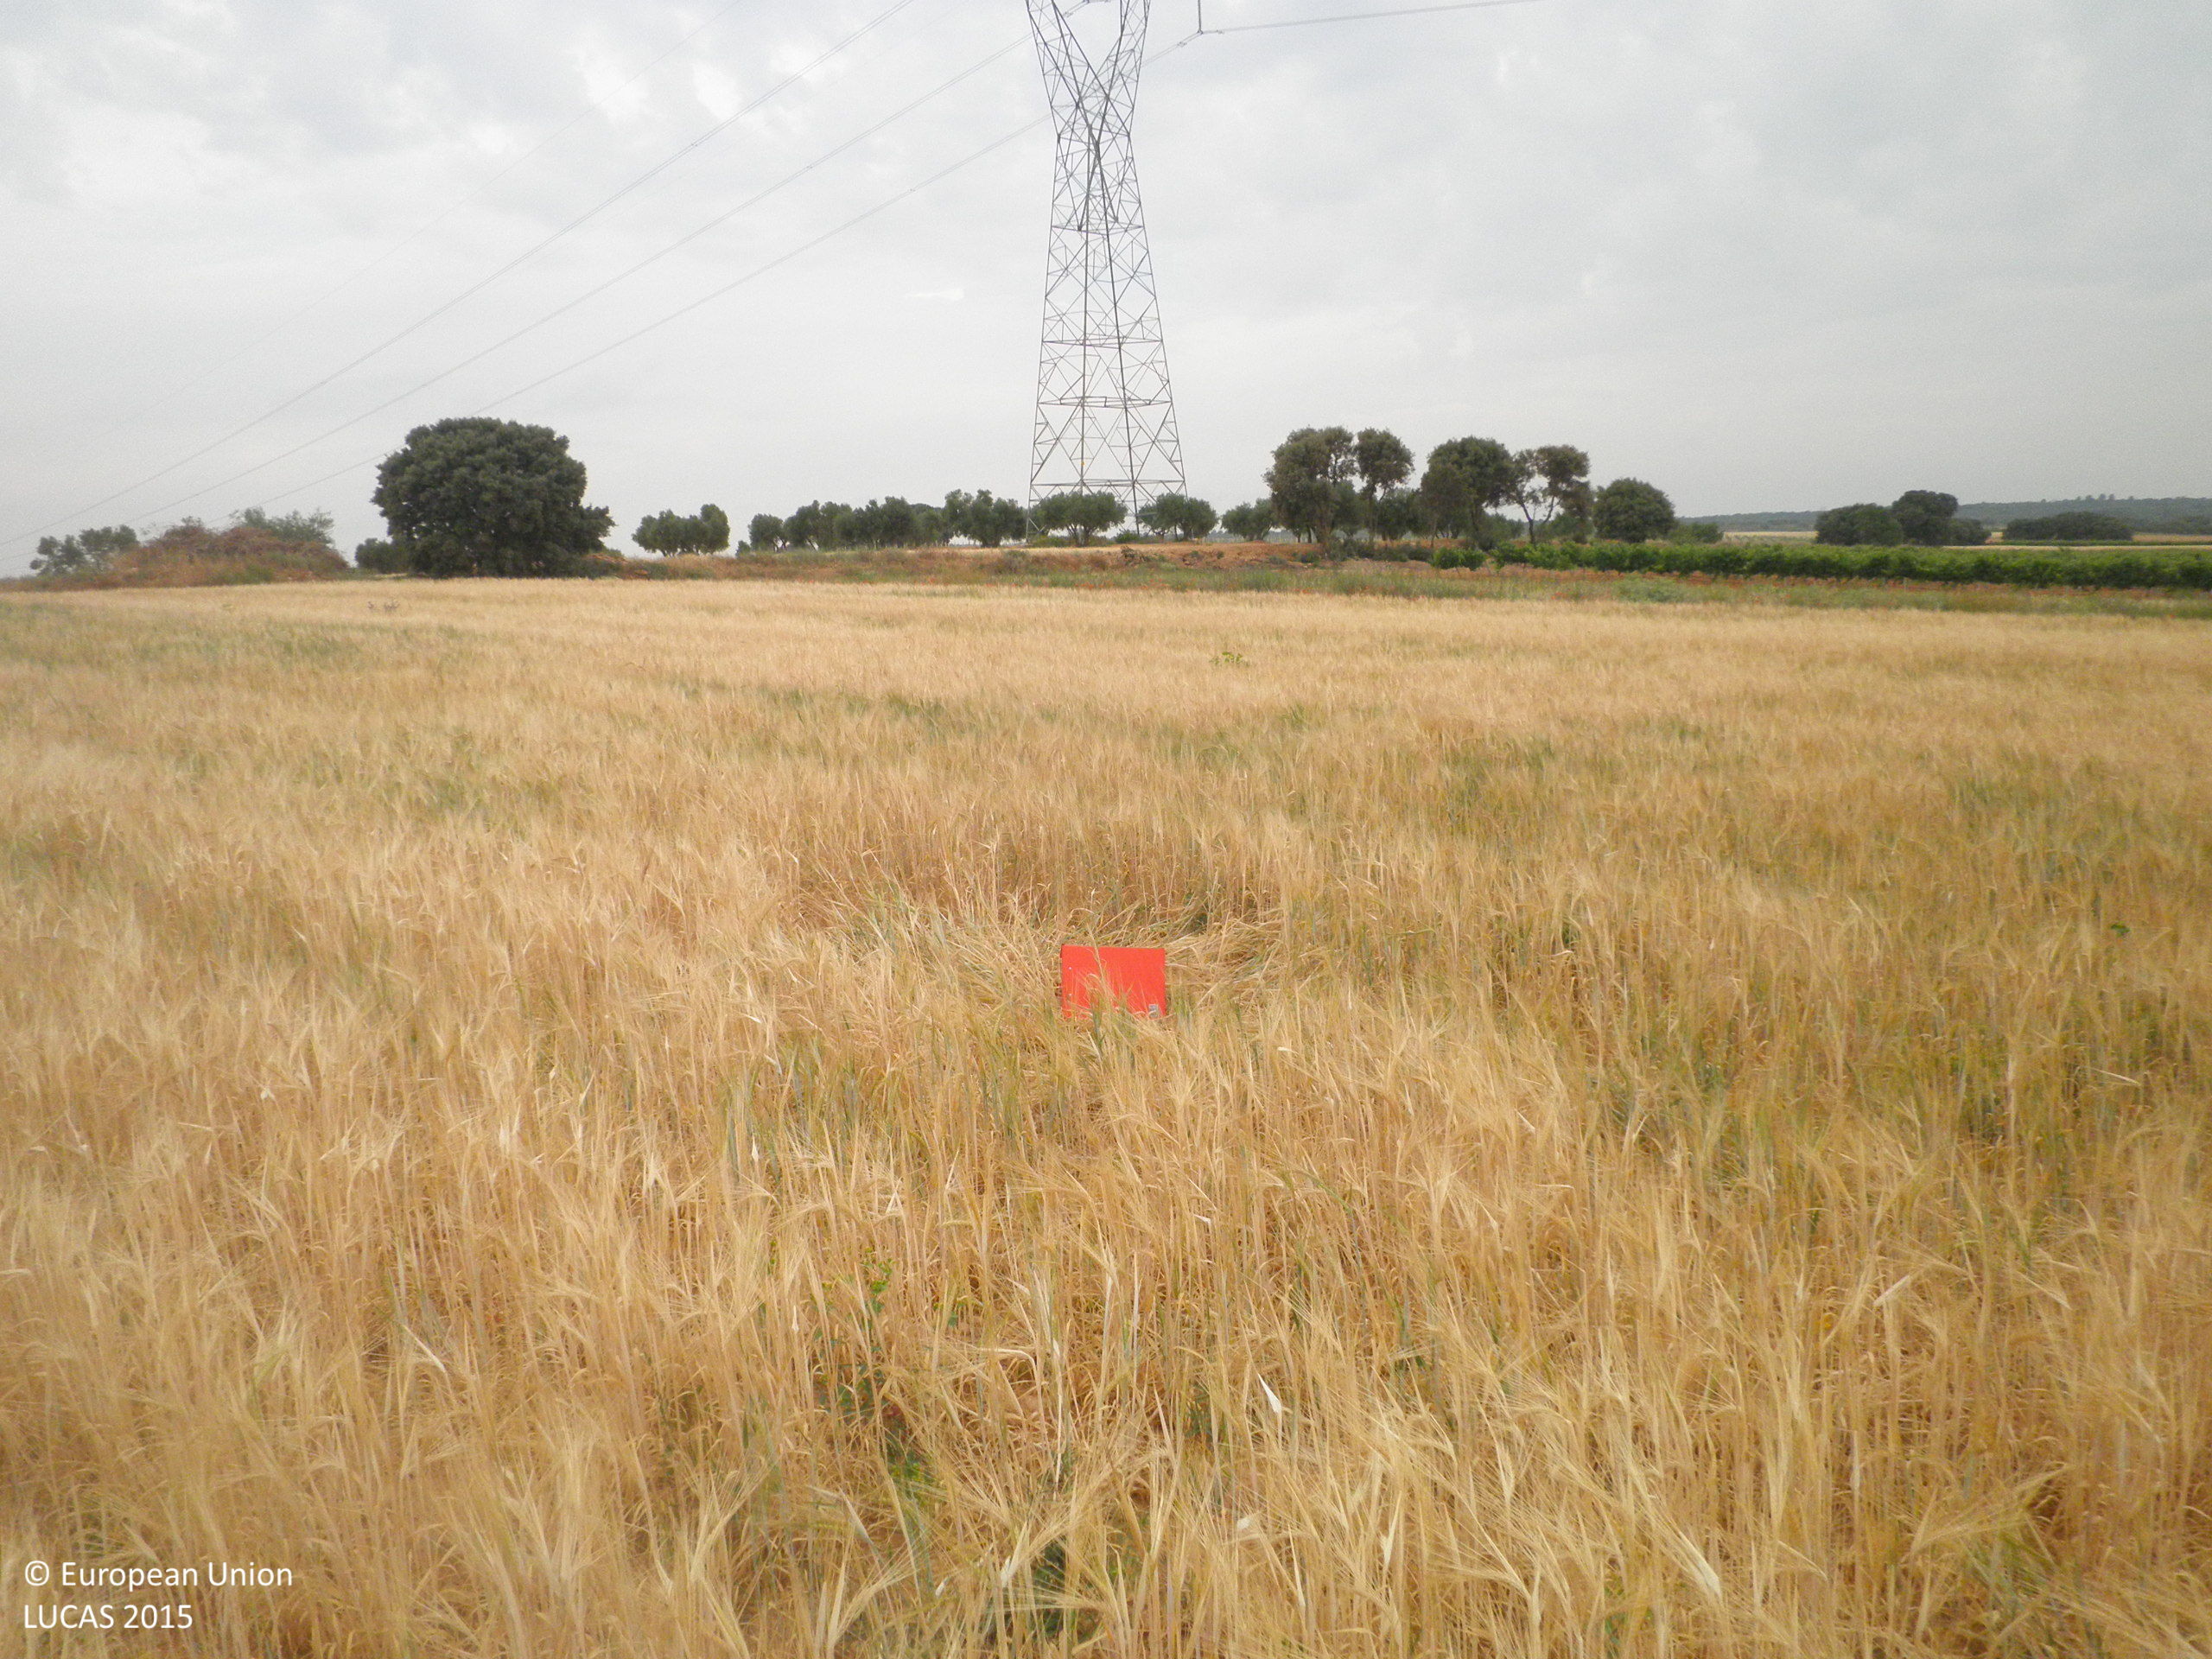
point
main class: Cropland
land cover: Barley
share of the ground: > 75 %
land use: Agriculture (excluding fallow land and kitchen gardens)
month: June
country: ES
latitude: 39.5257
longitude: -1.7206
